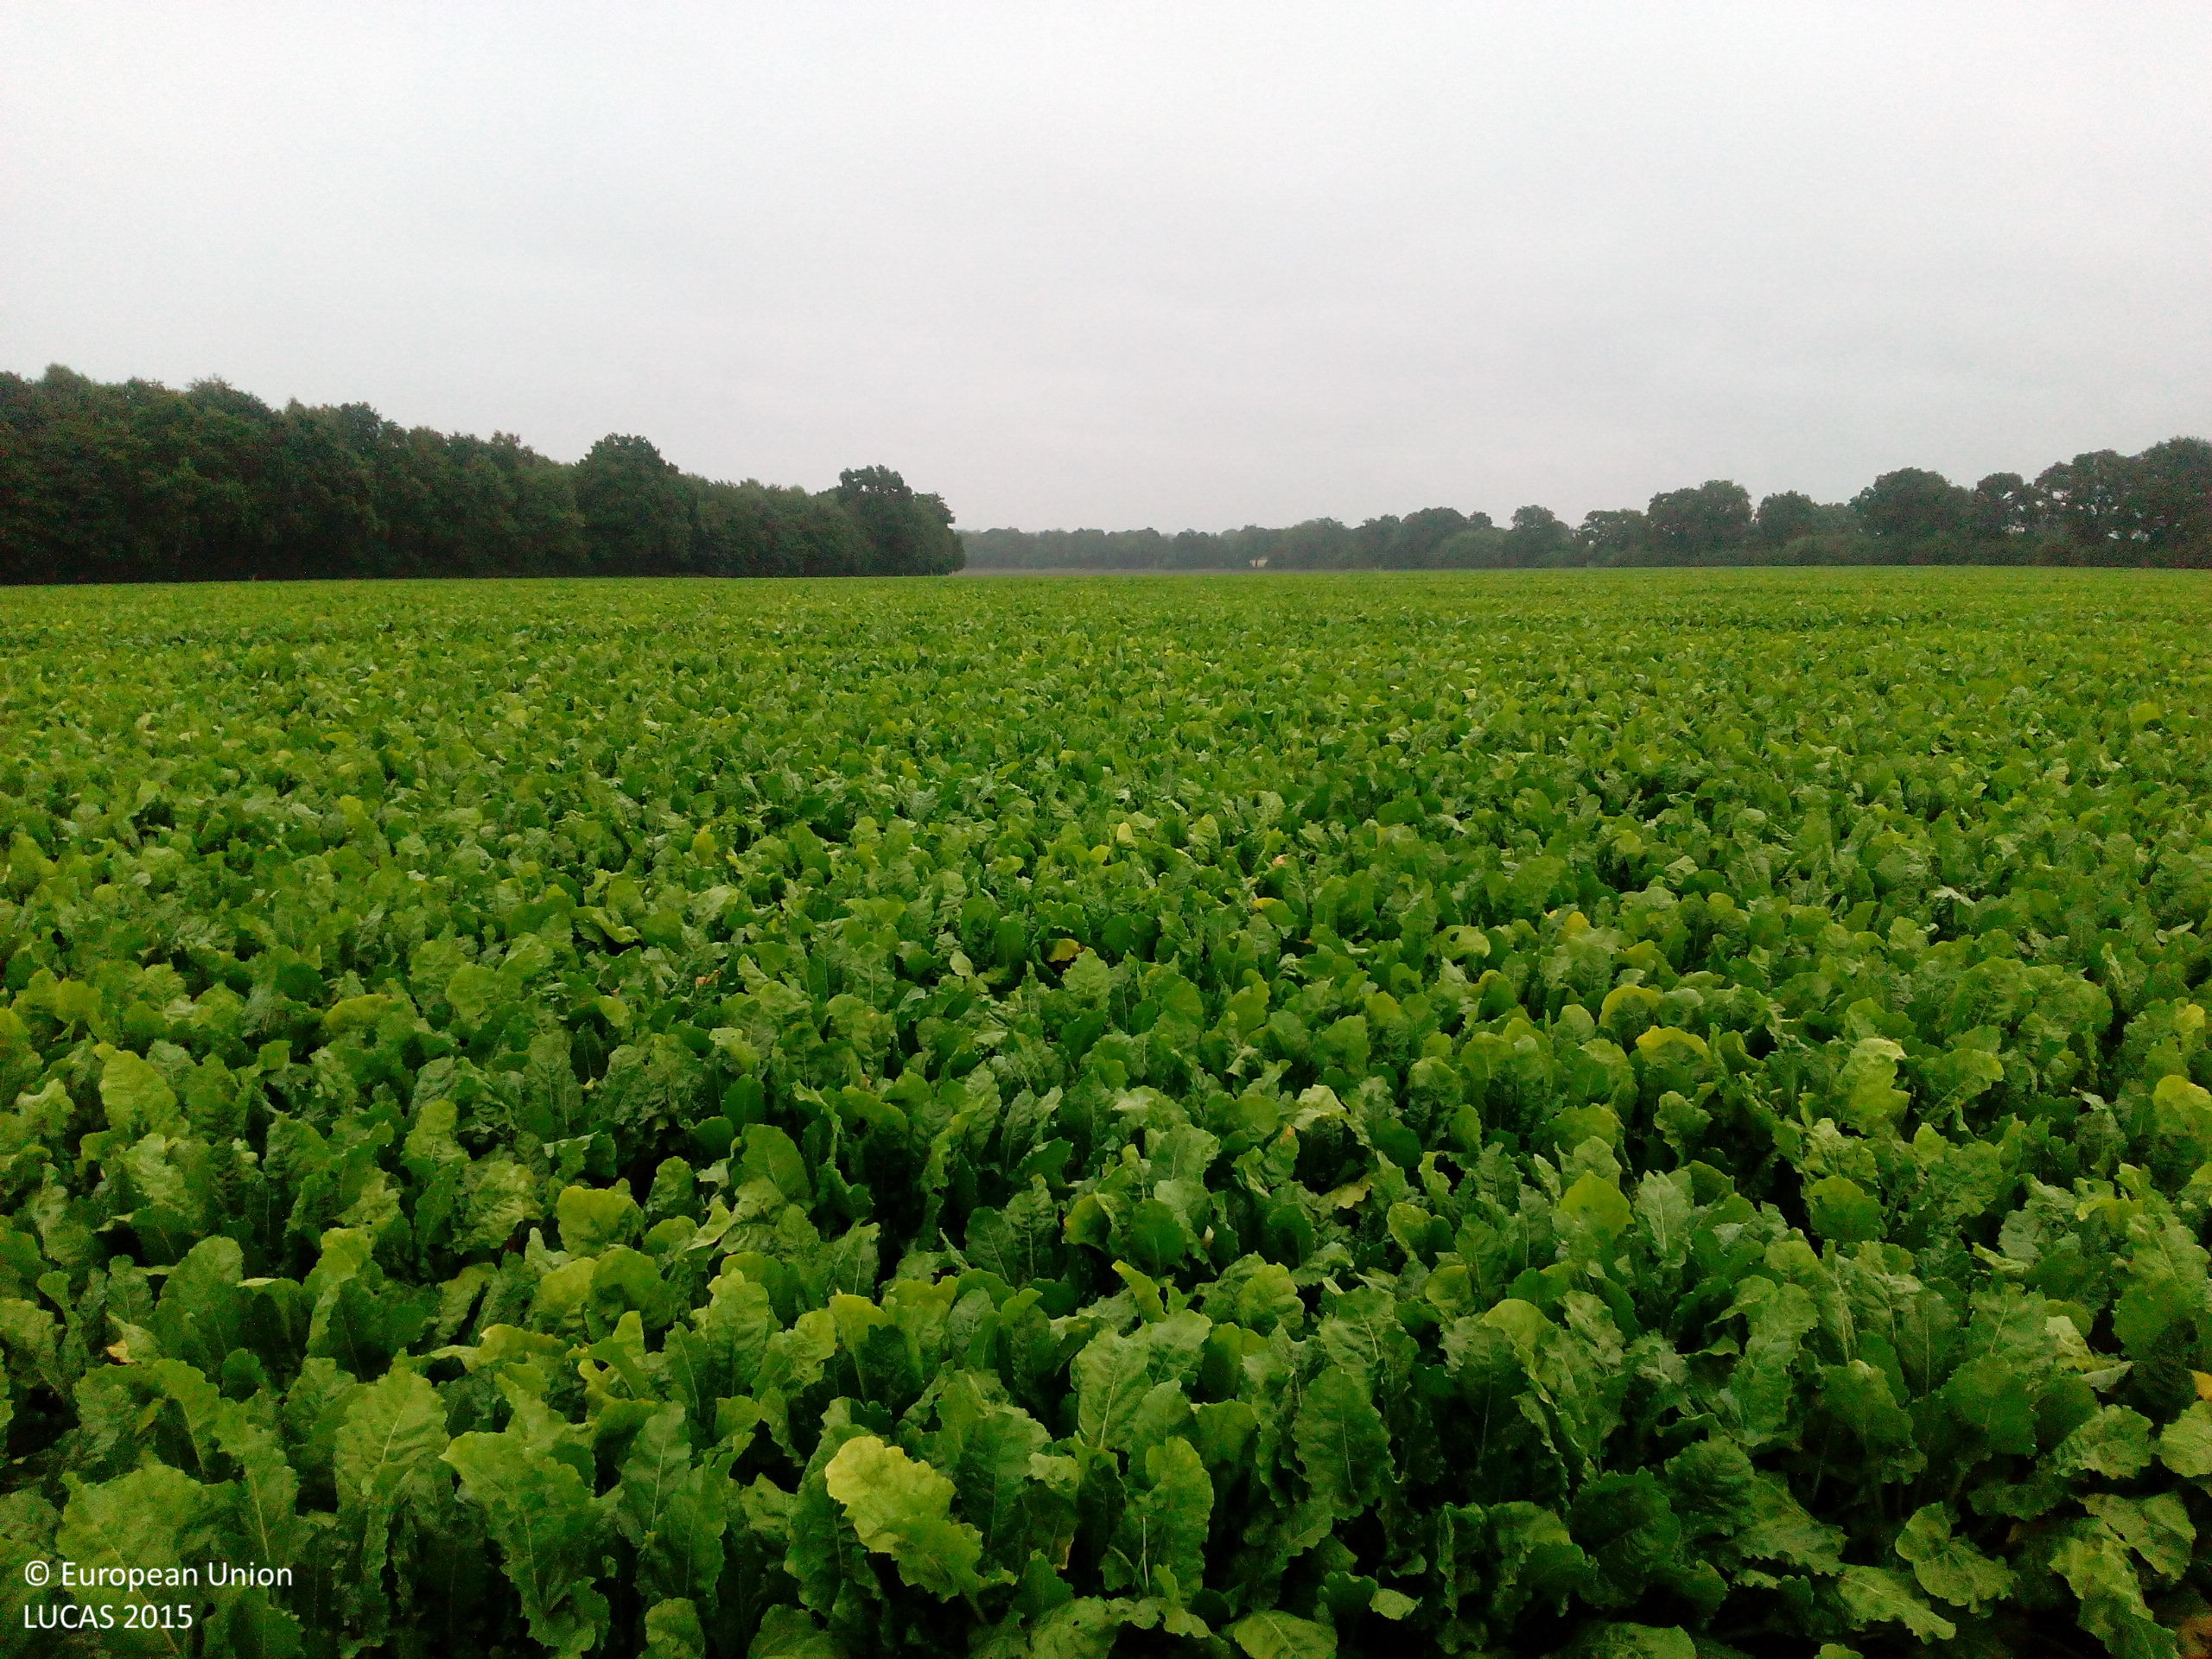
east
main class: Cropland
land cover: Sugar beet
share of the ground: > 75 %
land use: Agriculture (excluding fallow land and kitchen gardens)
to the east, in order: Sugar beet
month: August
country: DE
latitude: 53.7793
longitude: 9.9242
